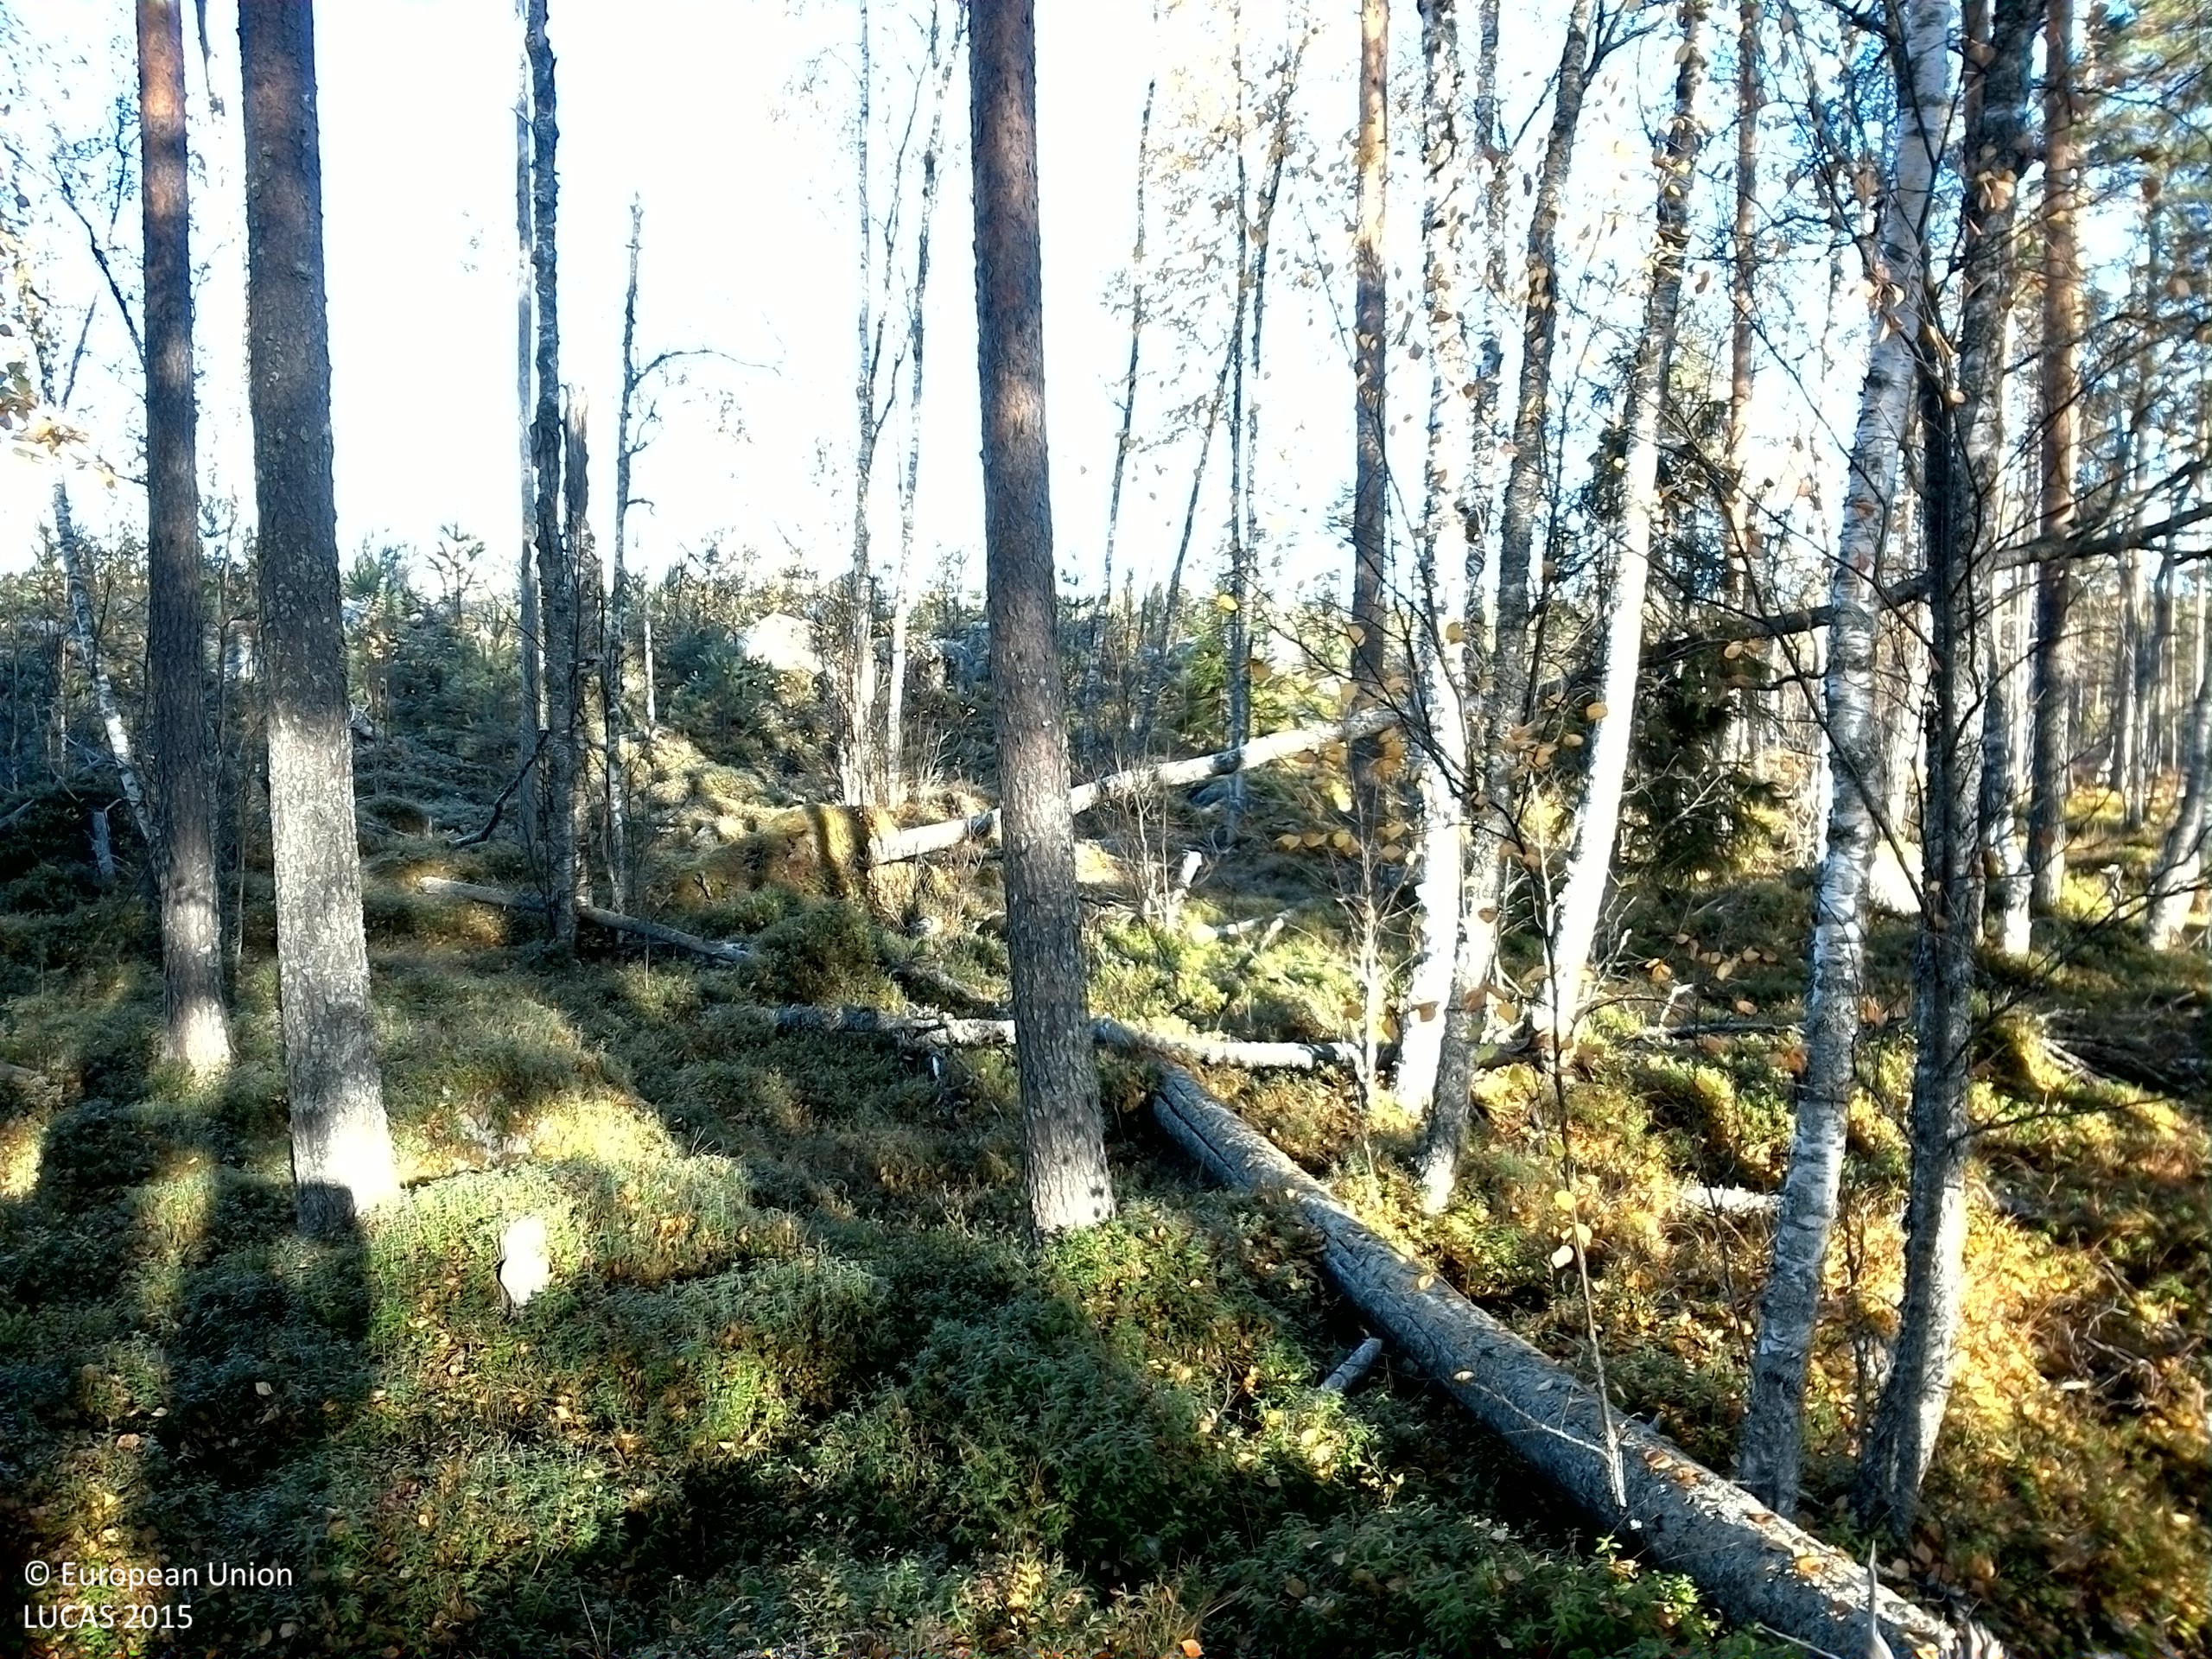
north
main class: Woodland
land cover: Pine dominated mixed woodland
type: boreal forest
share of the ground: 50 - 75 %
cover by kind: coniferous forest trees 35 %, shrubs 25 %, broadleaved forest trees 20 %, lichens and mosses 10 %, consolidated bare surface 10 %
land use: Forestry
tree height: > 5 m
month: October
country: SE
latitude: 61.3702
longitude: 15.0923
